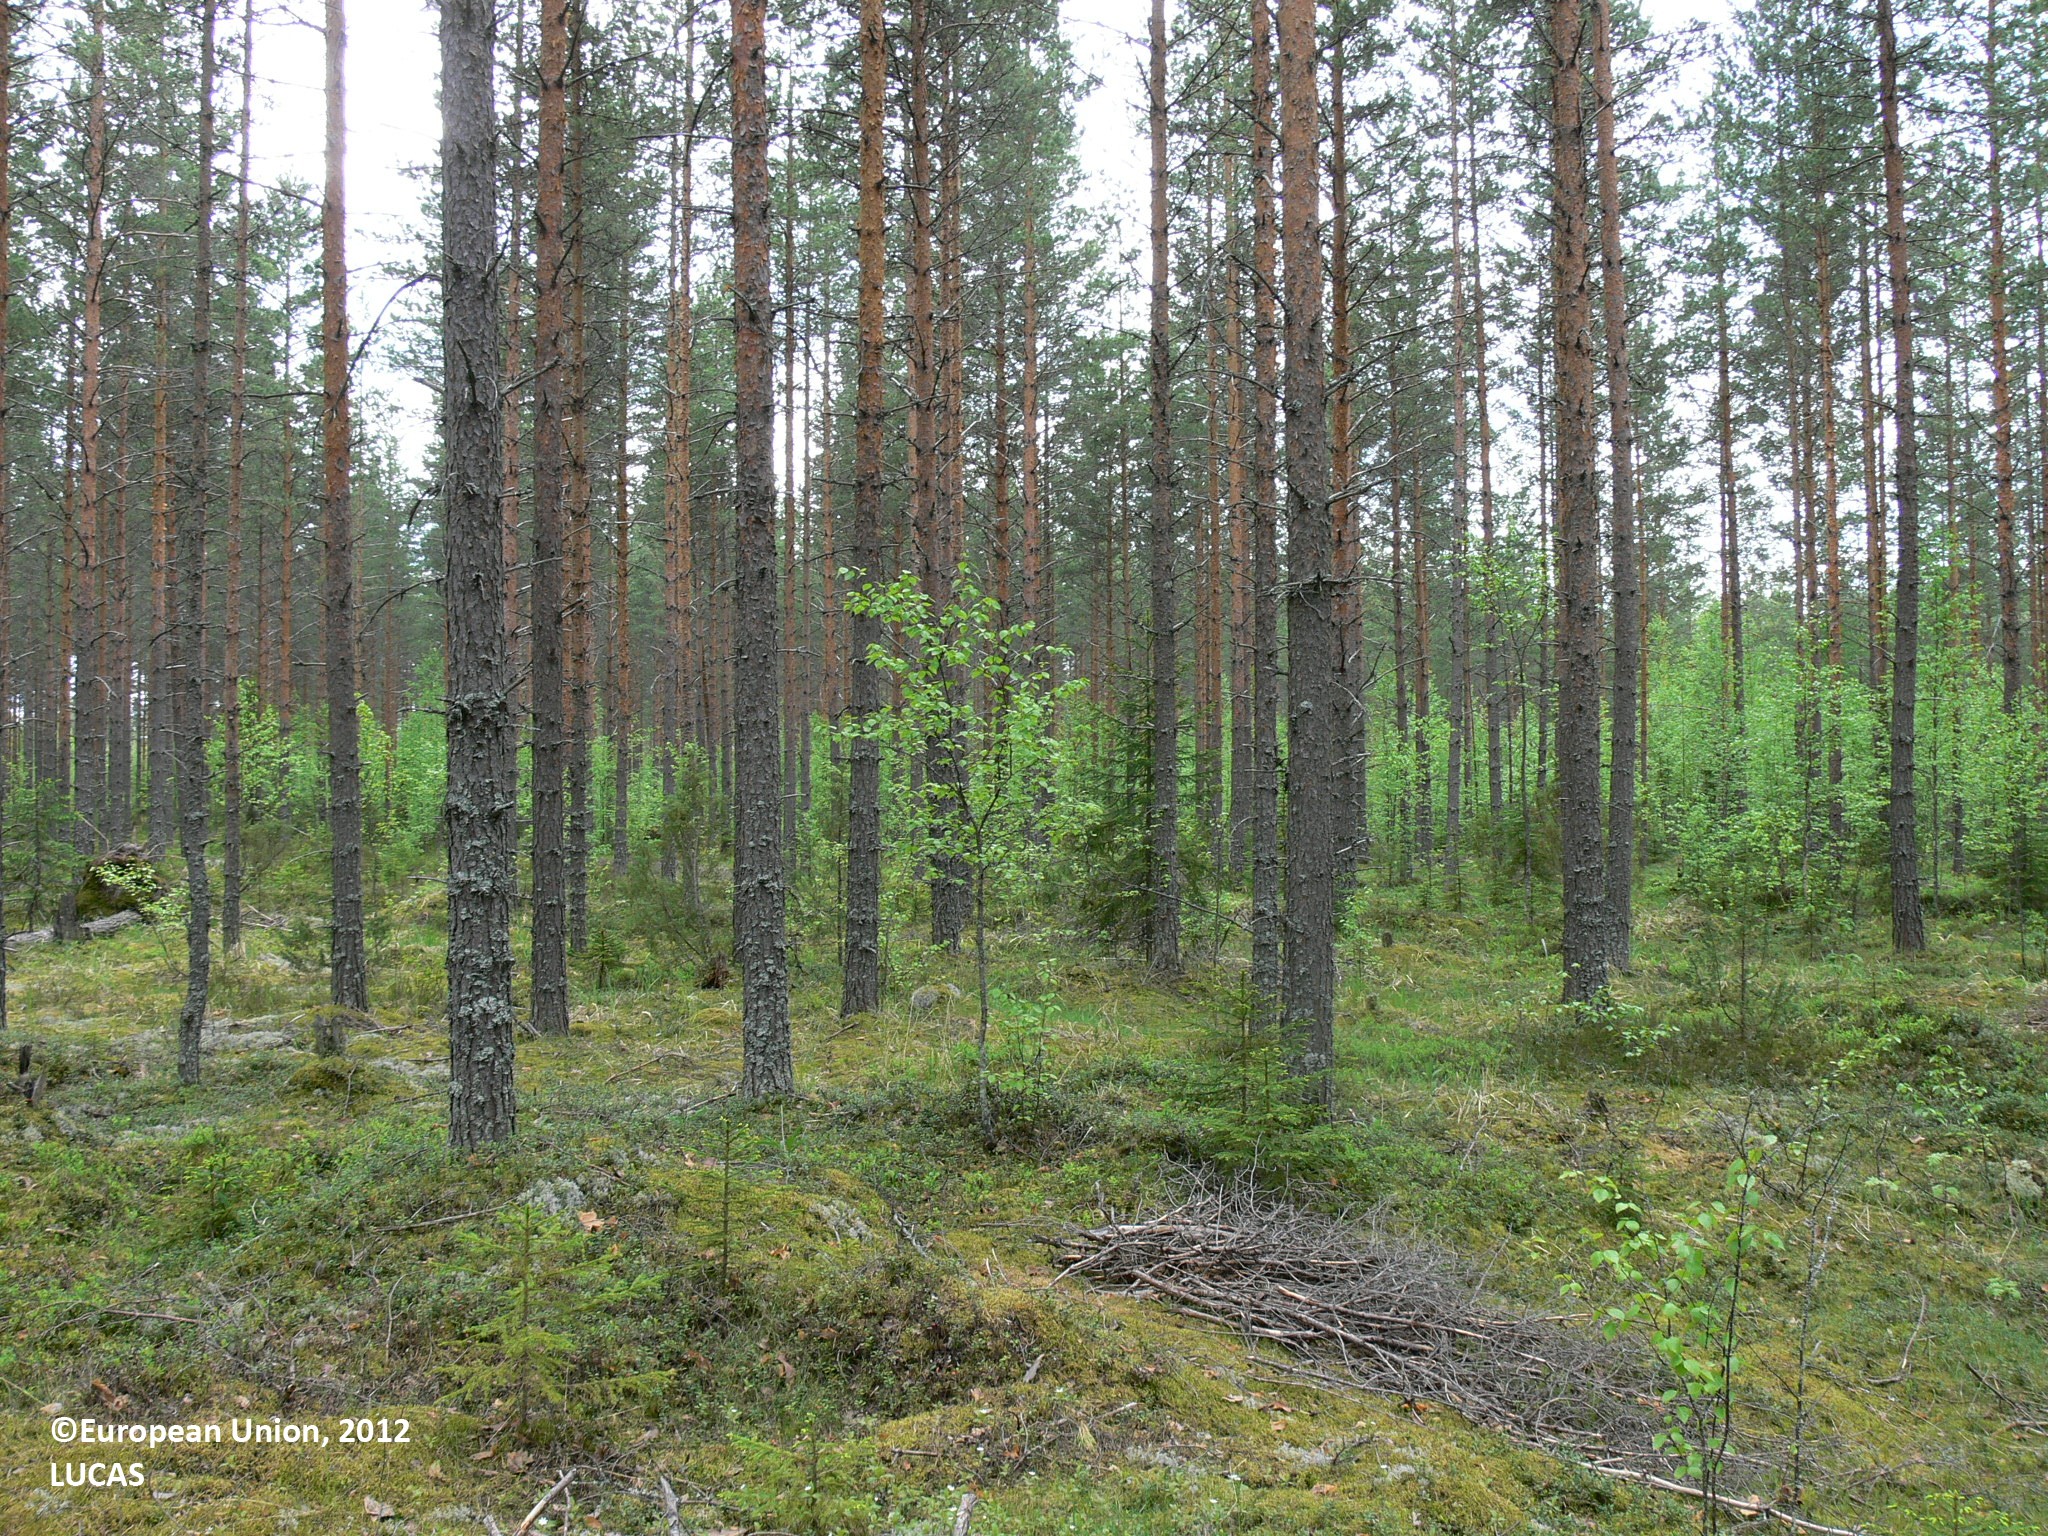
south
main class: Woodland
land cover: Pine dominated coniferous woodland
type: boreal forest
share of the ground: > 75 %
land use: Forestry
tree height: > 5 m
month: June
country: FI
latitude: 62.2679
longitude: 30.3305
